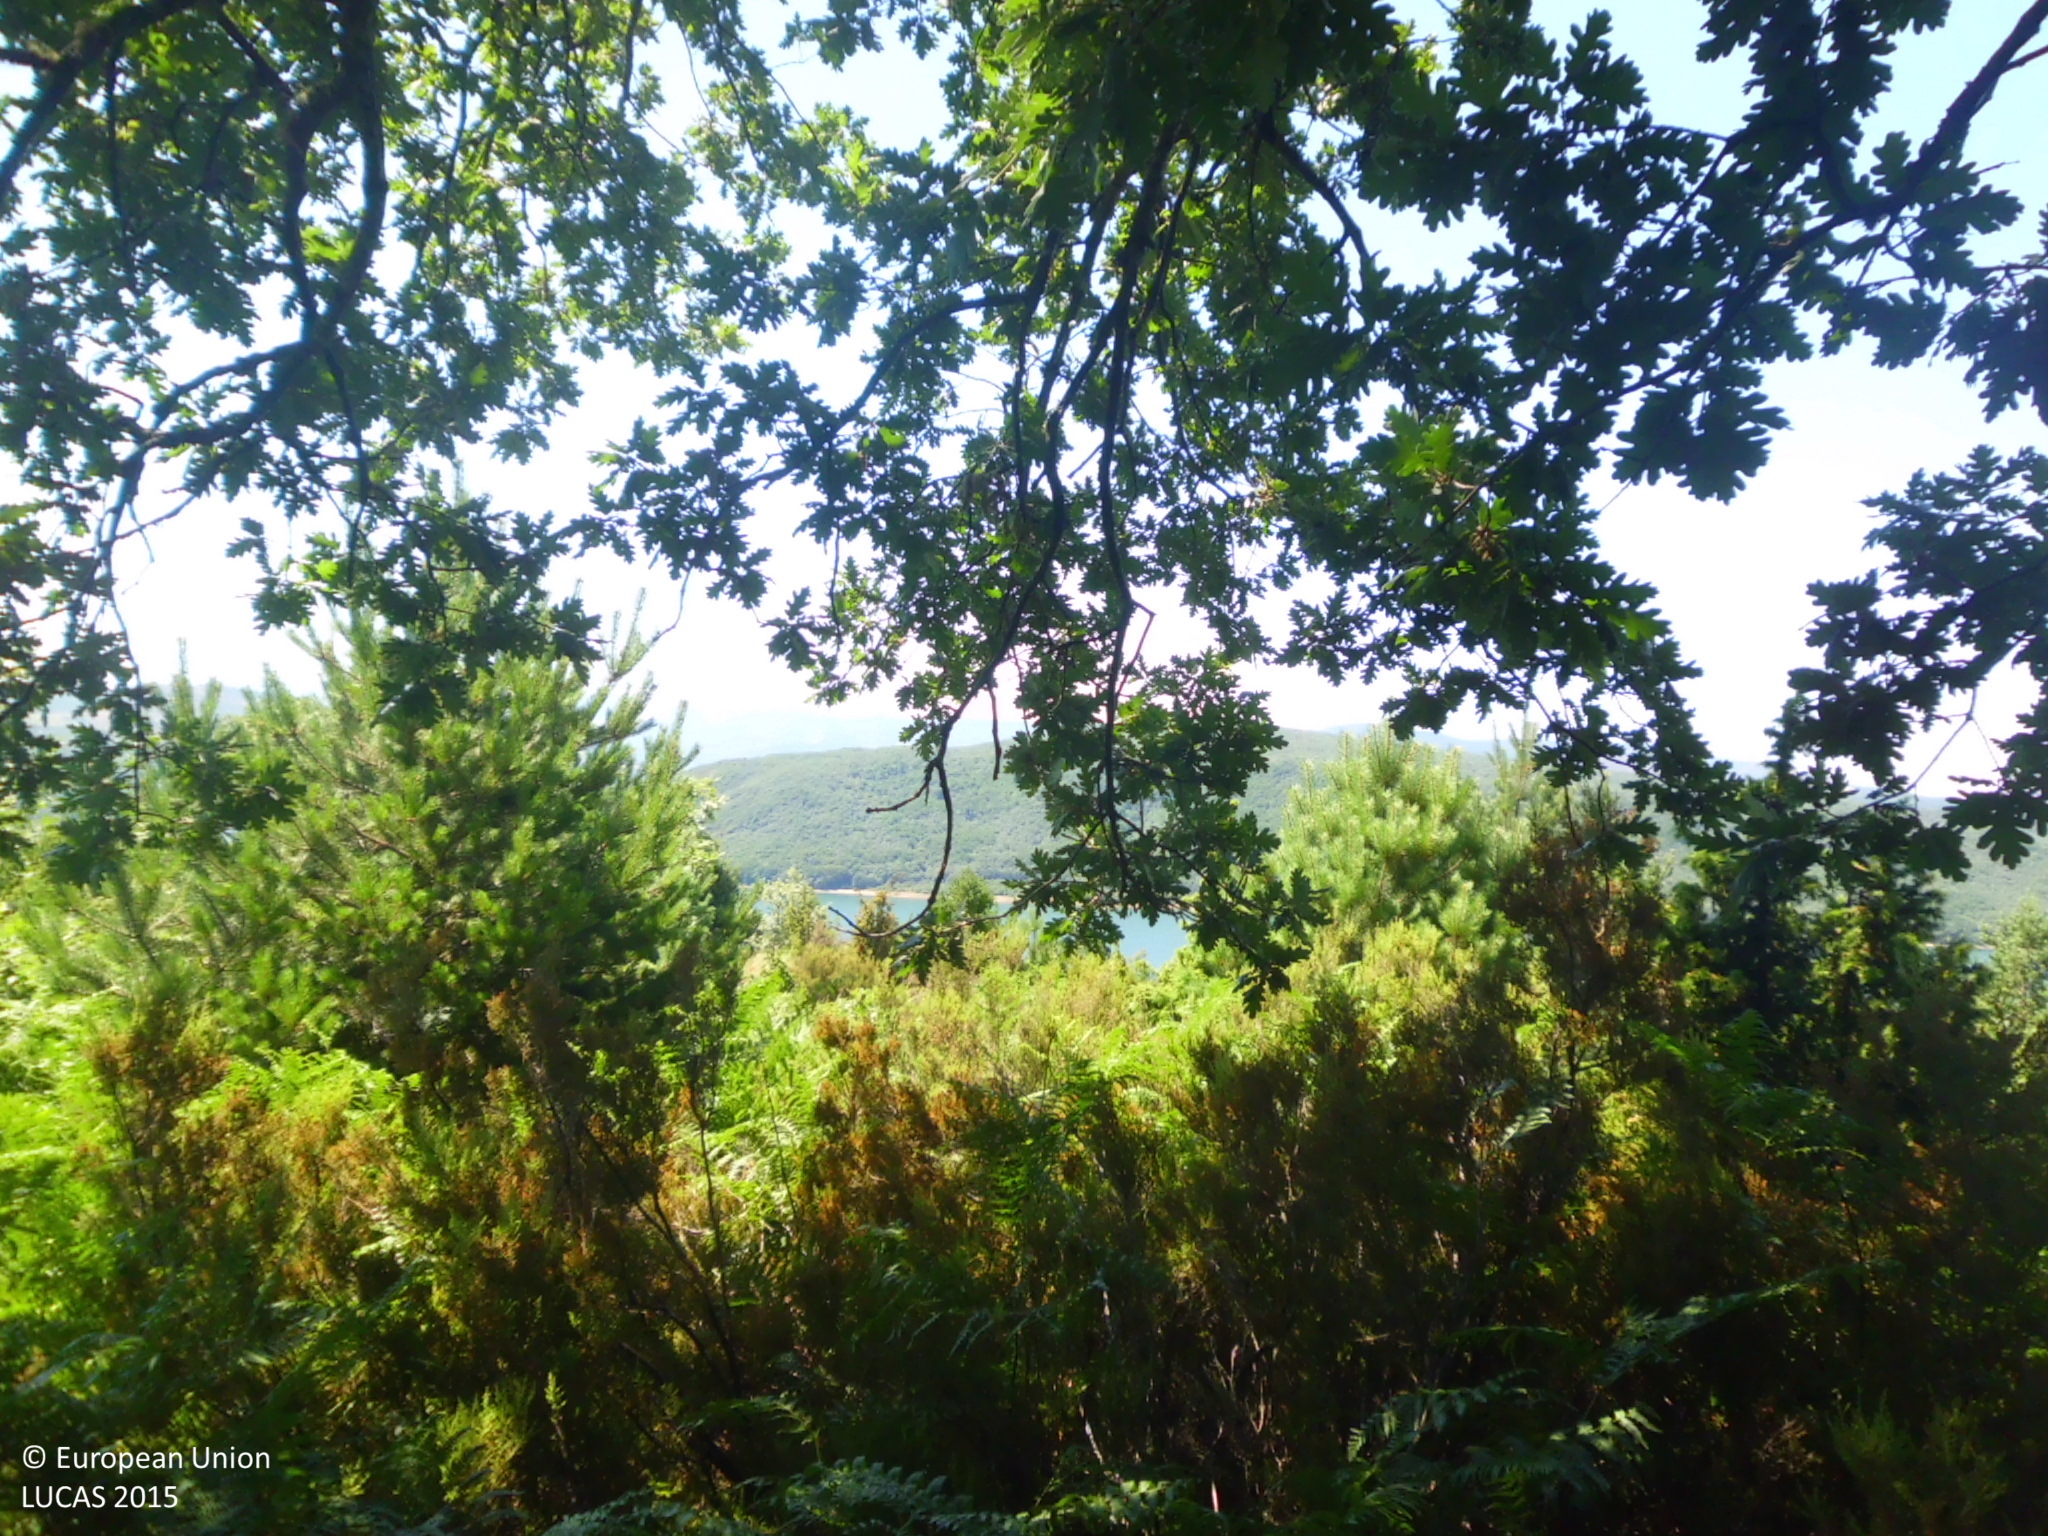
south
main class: Woodland
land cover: Broadleaved woodland
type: acidophilous oak and oak-birch forest
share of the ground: 10 - 25 %
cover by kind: shrubs 60 %, broadleaved forest trees 20 %, herbaceous plants 20 %
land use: Agriculture (excluding fallow land and kitchen gardens)
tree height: > 5 m
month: July
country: ES
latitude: 42.3155
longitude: -3.3405
